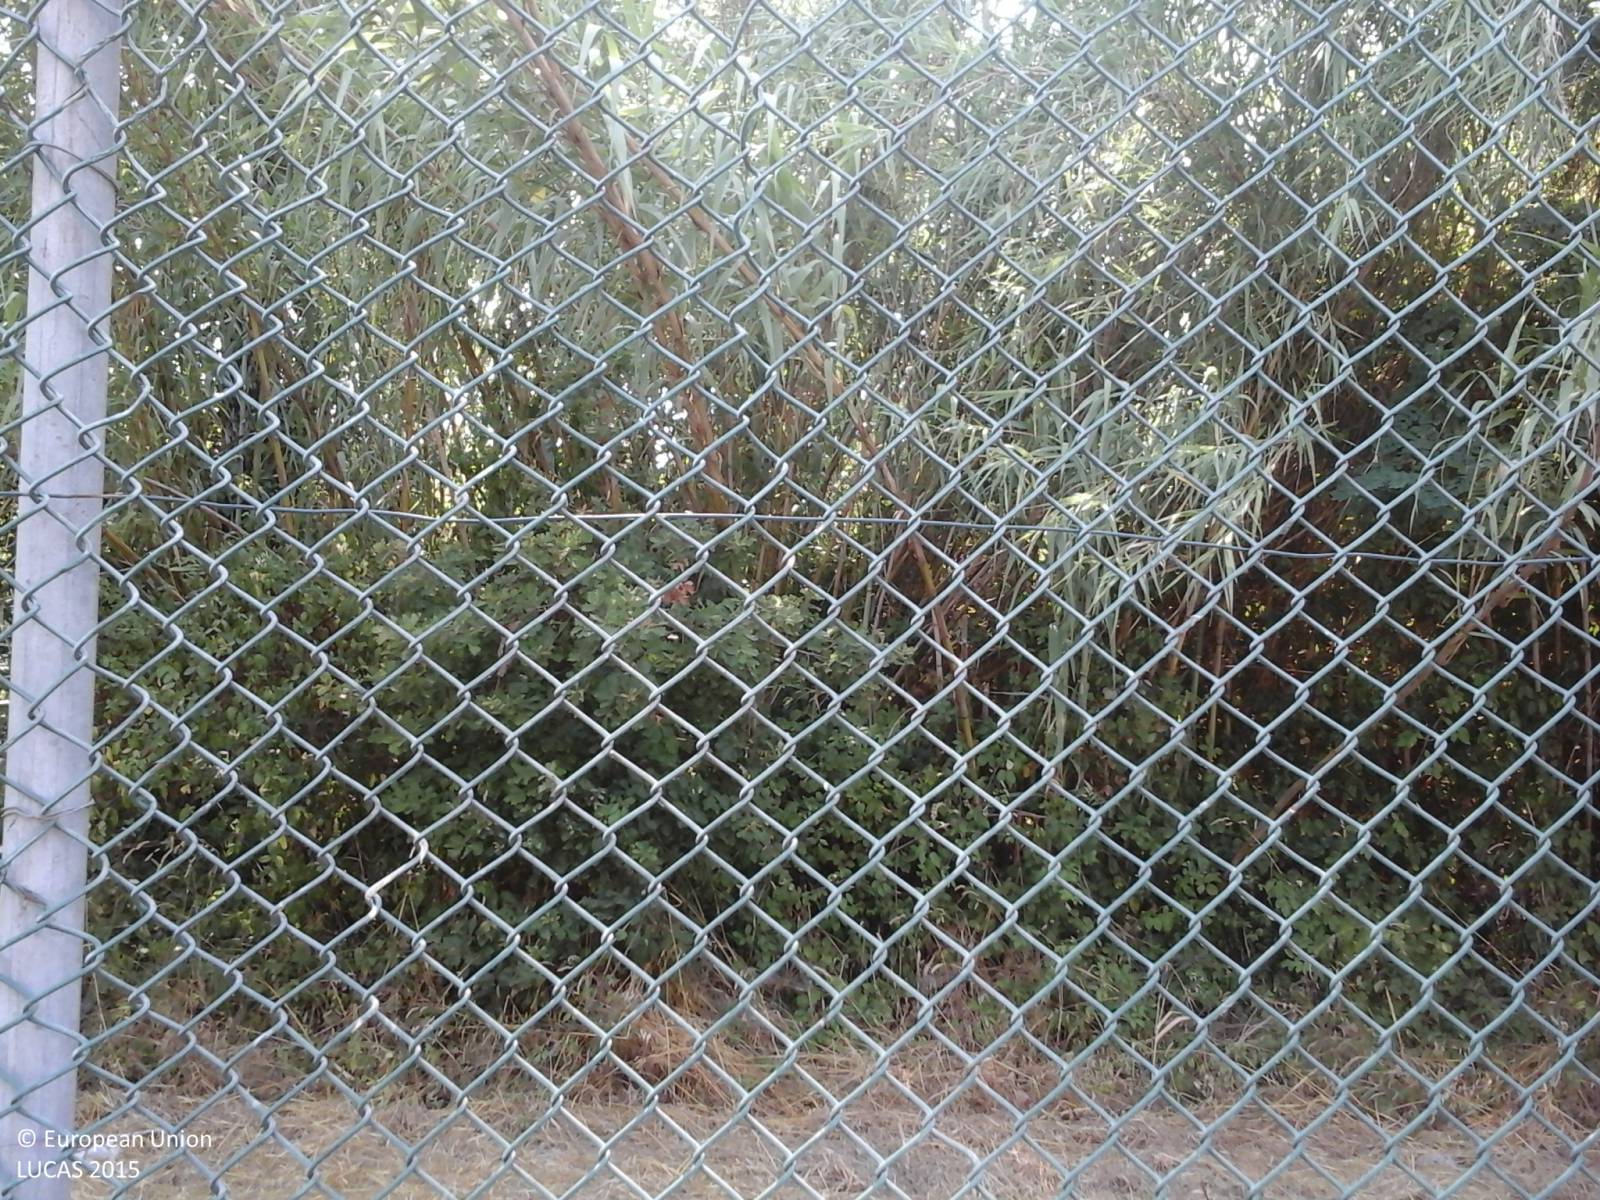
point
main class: Woodland
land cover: Broadleaved woodland
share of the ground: > 75 %
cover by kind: broadleaved forest trees 100 %
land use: Community services
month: July
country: IT
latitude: 41.0213
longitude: 13.9439
